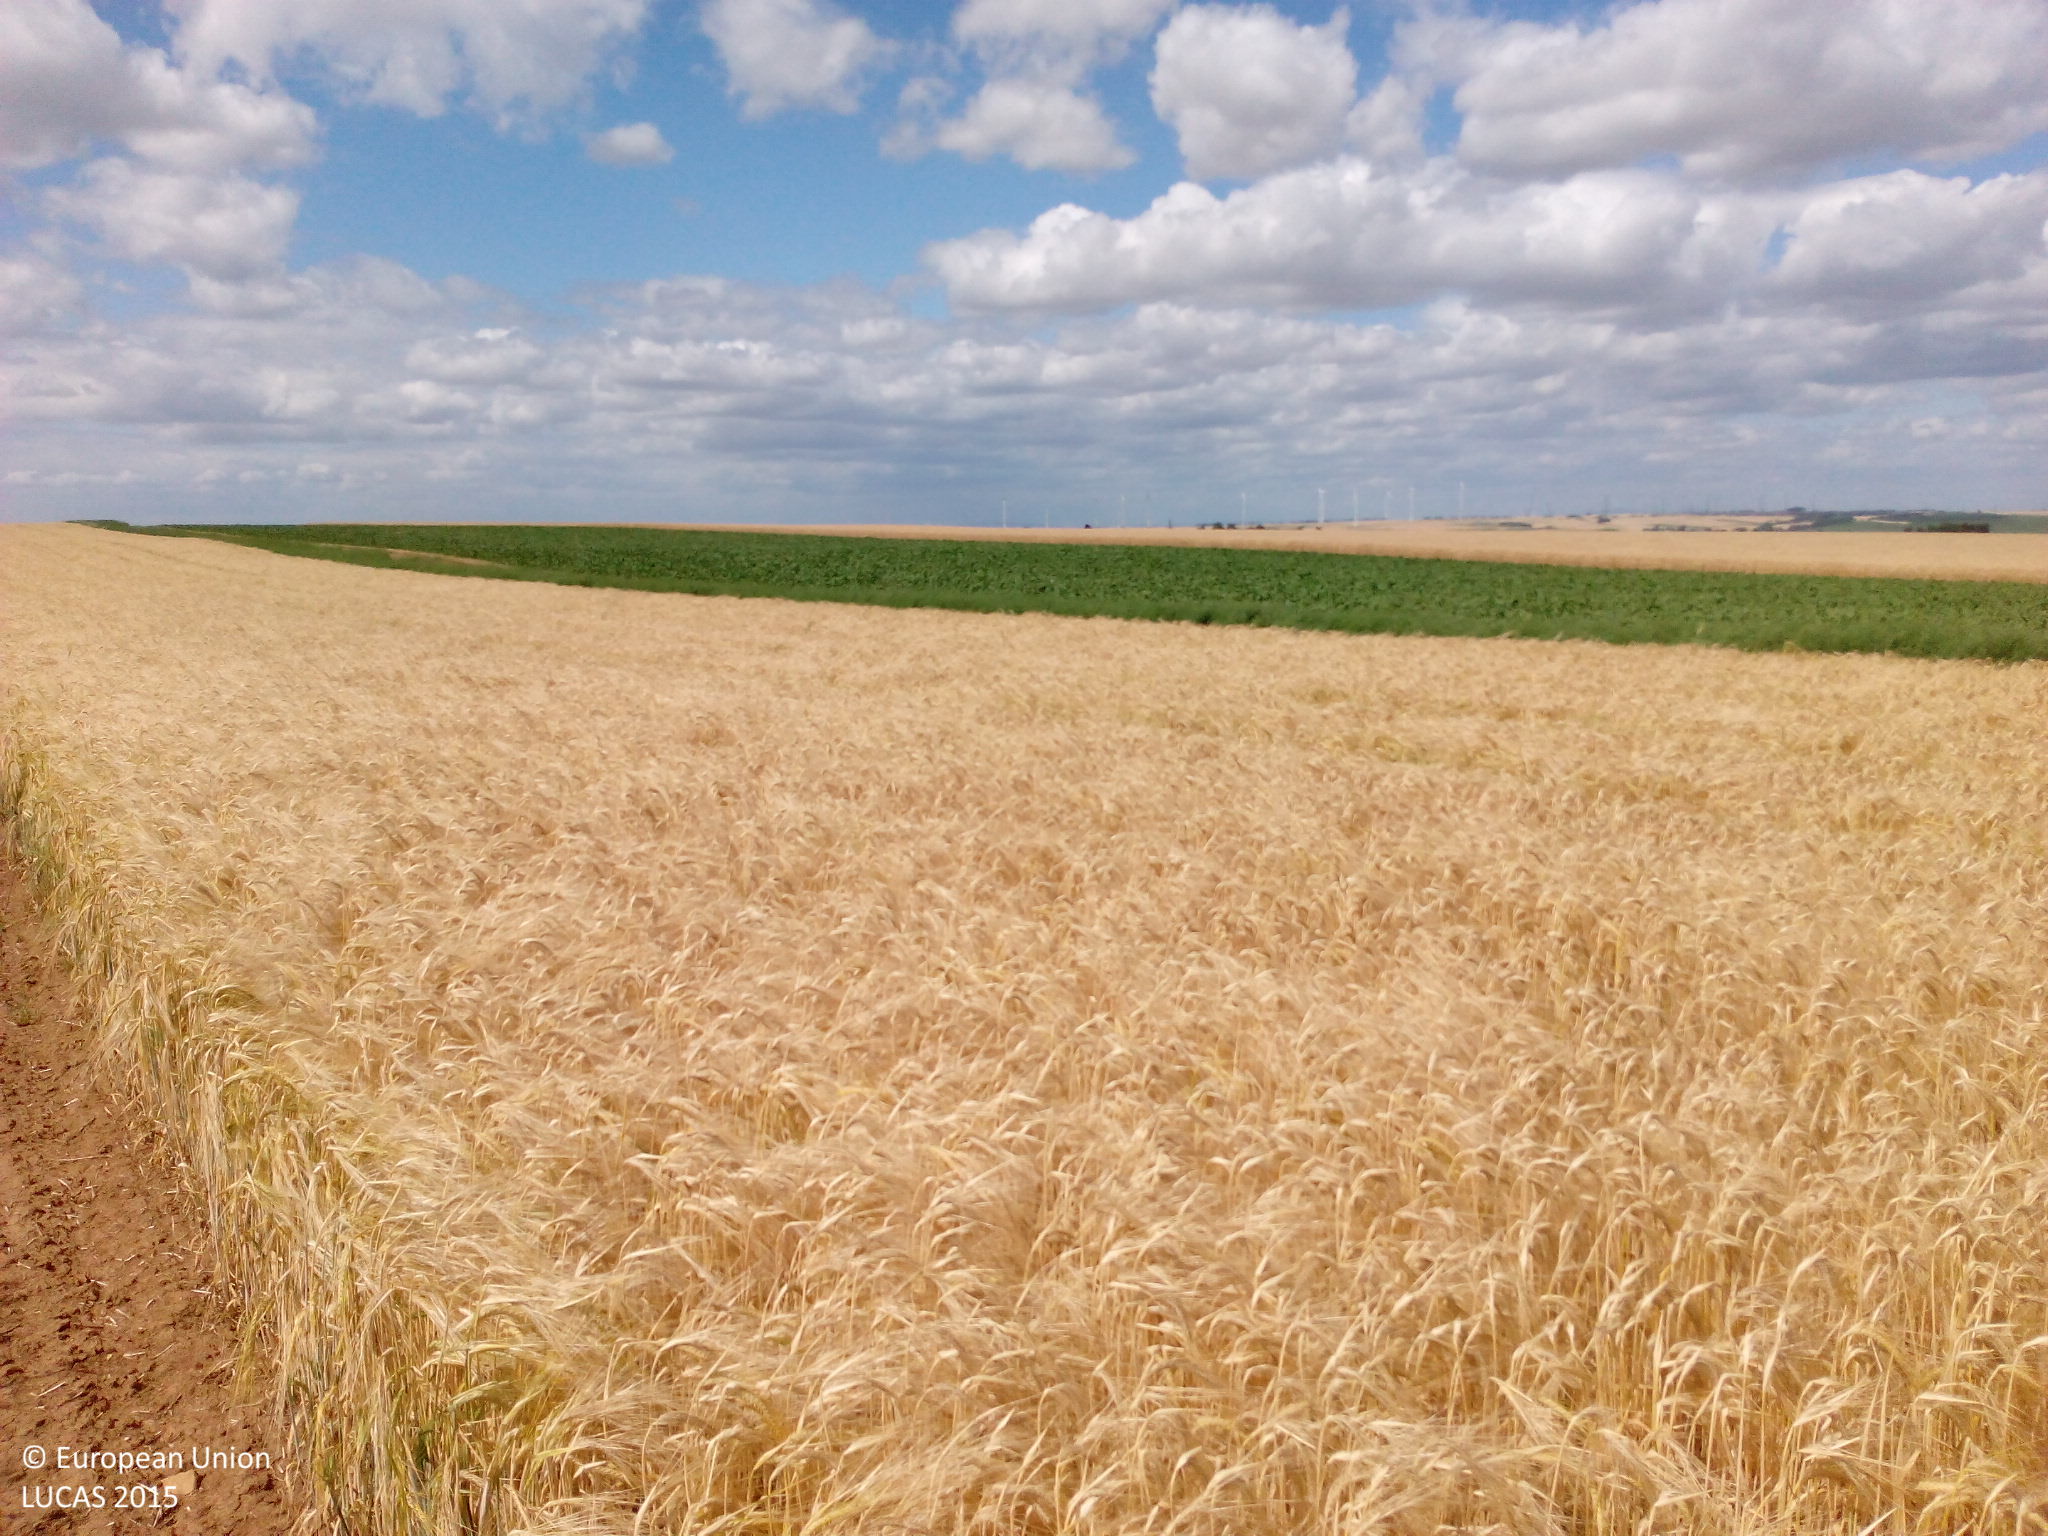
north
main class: Cropland
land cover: Barley
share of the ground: > 75 %
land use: Agriculture (excluding fallow land and kitchen gardens)
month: July
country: DE
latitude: 49.6657
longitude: 8.1578
